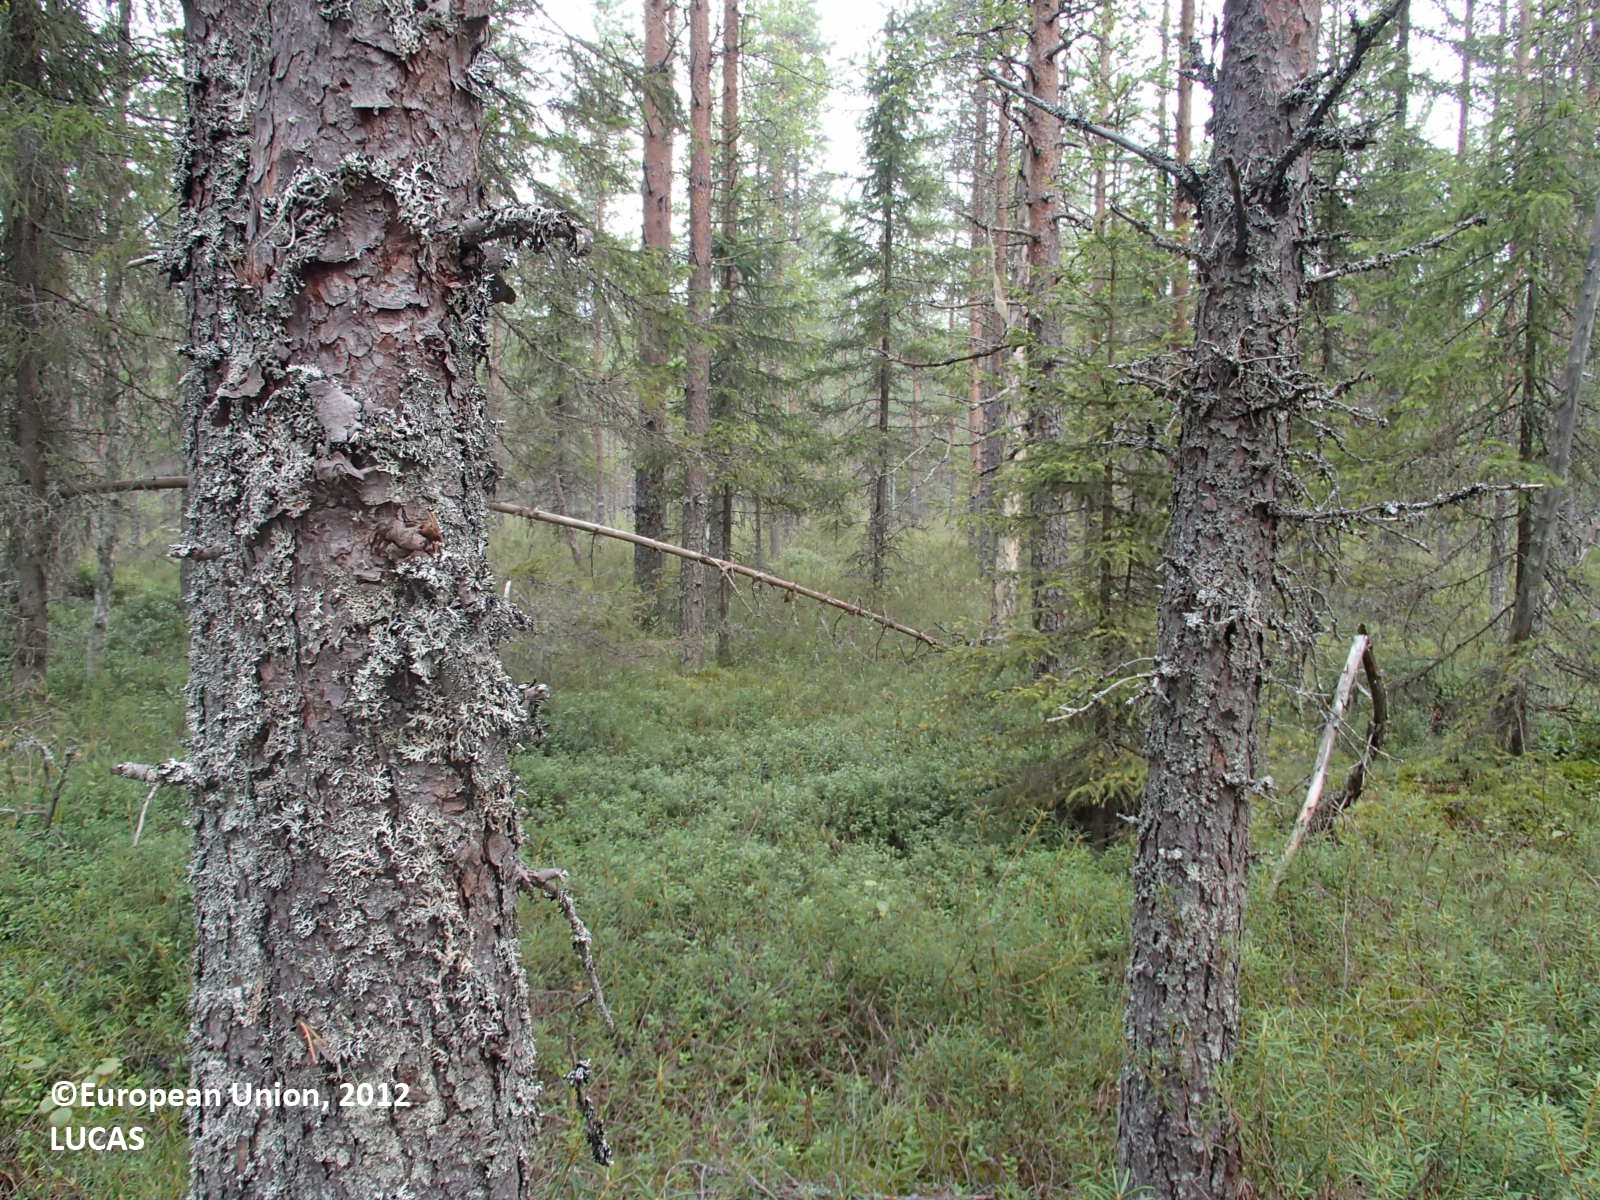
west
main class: Woodland
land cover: Other coniferous woodland
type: boreal forest
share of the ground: > 75 %
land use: Forestry
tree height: > 5 m
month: August
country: FI
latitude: 63.7875
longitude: 27.9632
